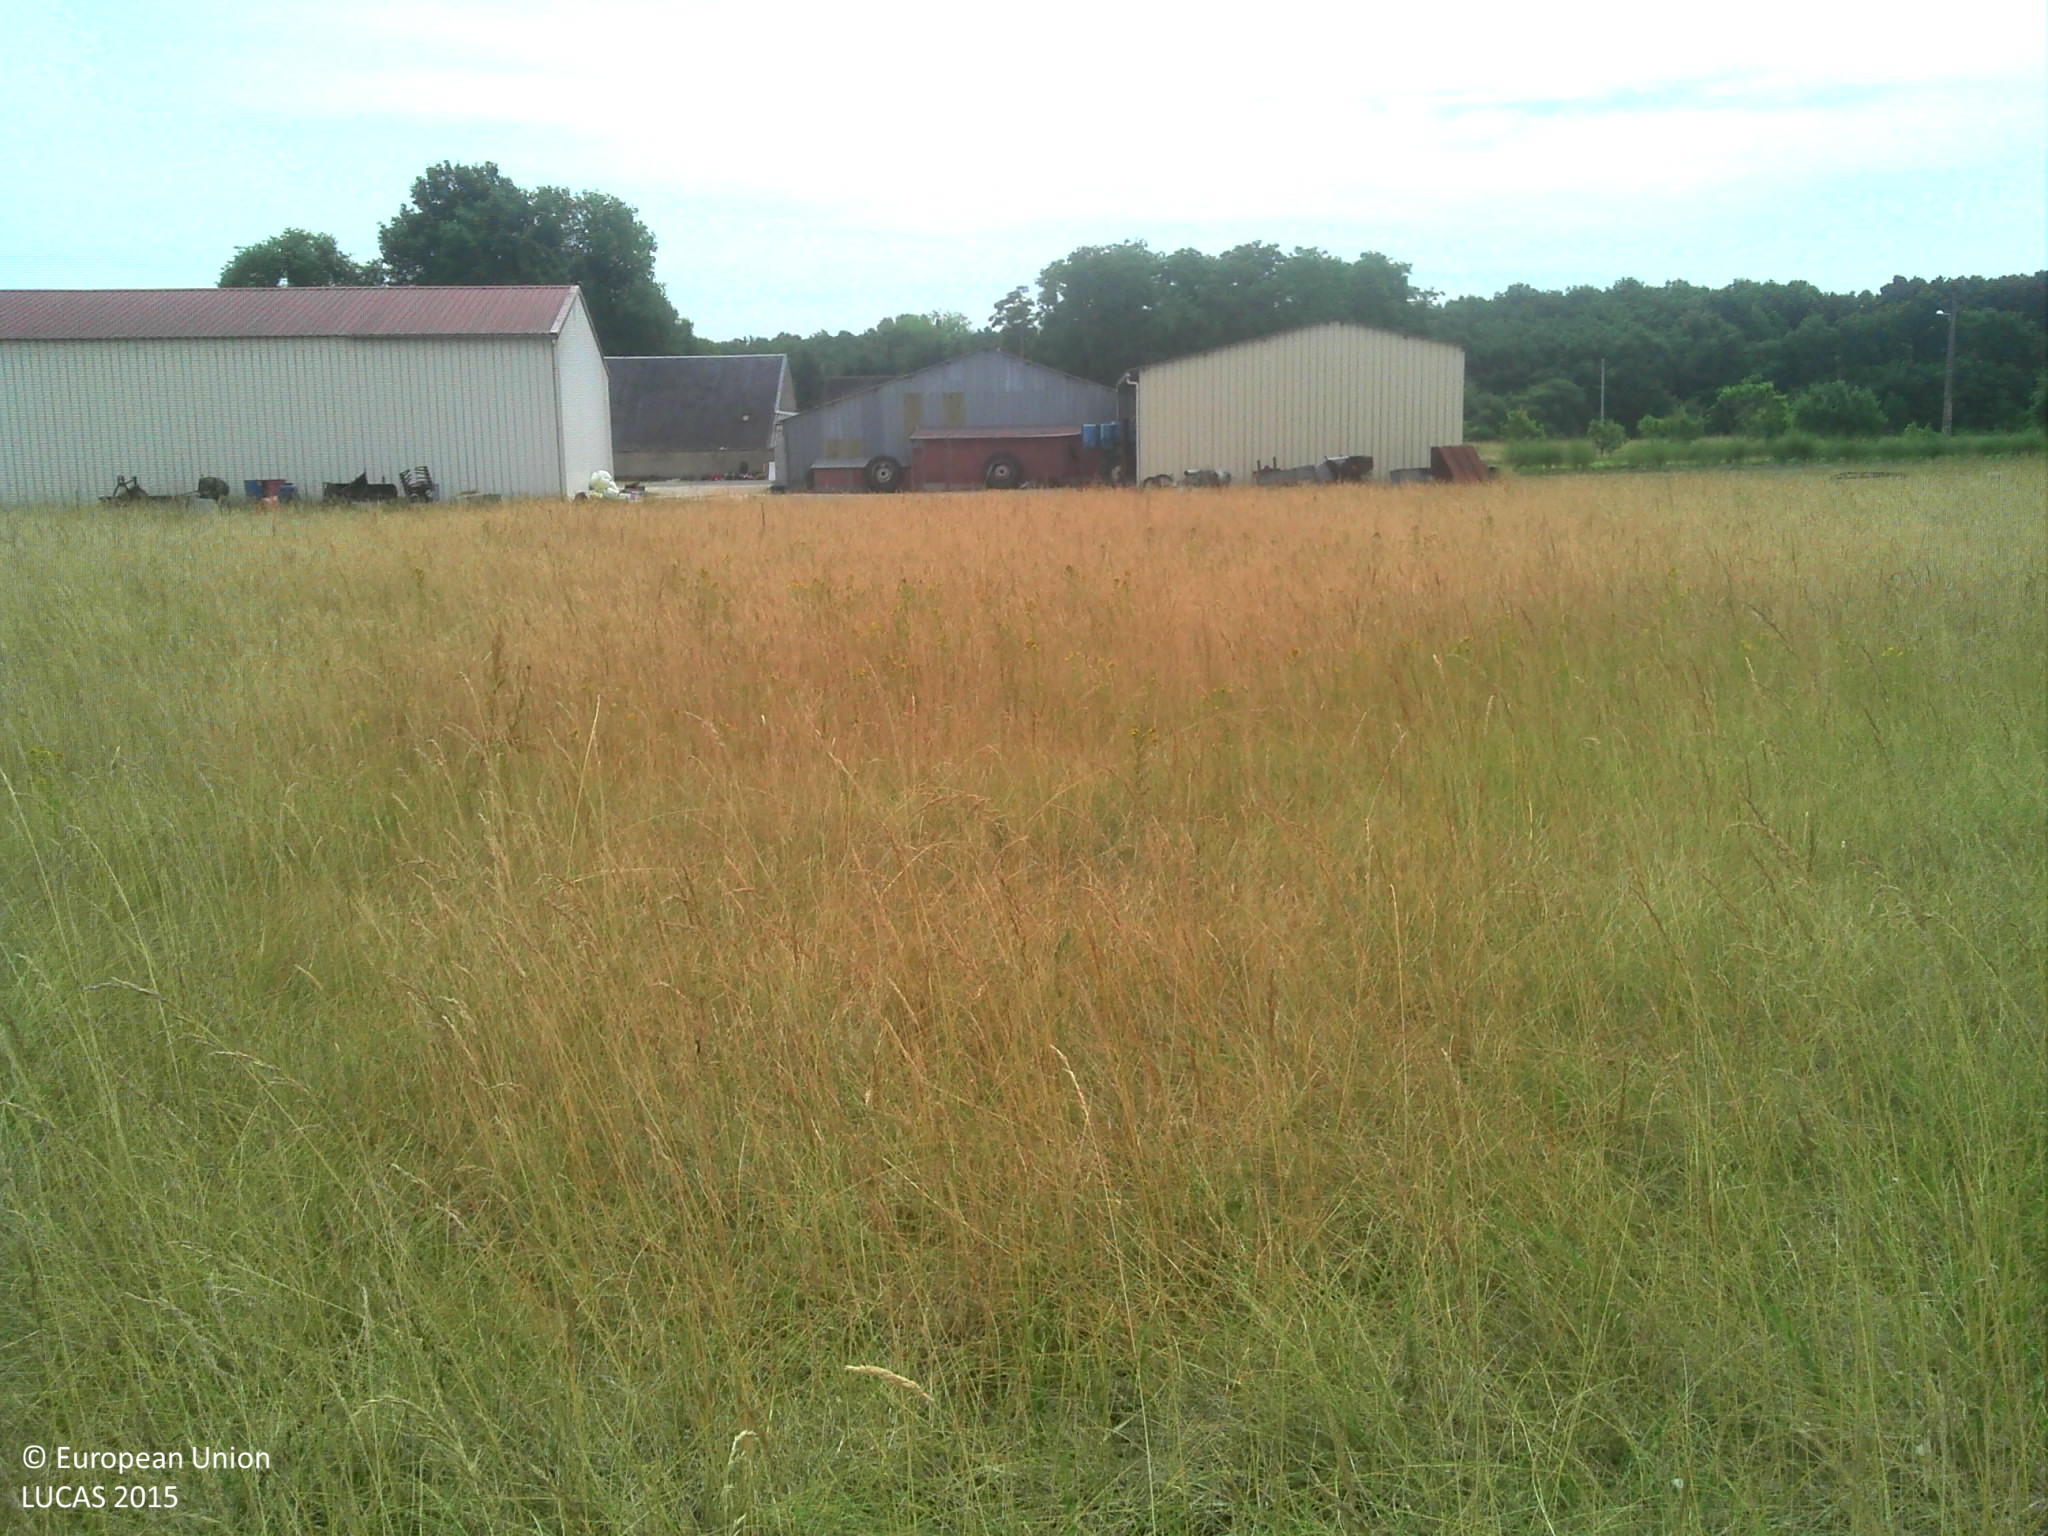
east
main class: Grassland
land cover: Grassland without tree/shrub cover
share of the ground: > 75 %
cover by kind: herbaceous plants 100 %
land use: Agriculture (excluding fallow land and kitchen gardens)
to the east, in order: Grassland without tree/shrub cover; Artificial constructions in urban areas; Cherry fruit; Common wheat; Artificial constructions in urban areas; Electric lines; Ditches and canals; Grass margins; Paved roads, cycling and walking lanes; Grass margins; Ditches and canals; Electric lines; Fences; Broadleaved woodland
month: June
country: FR
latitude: 47.3616
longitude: 1.3928
